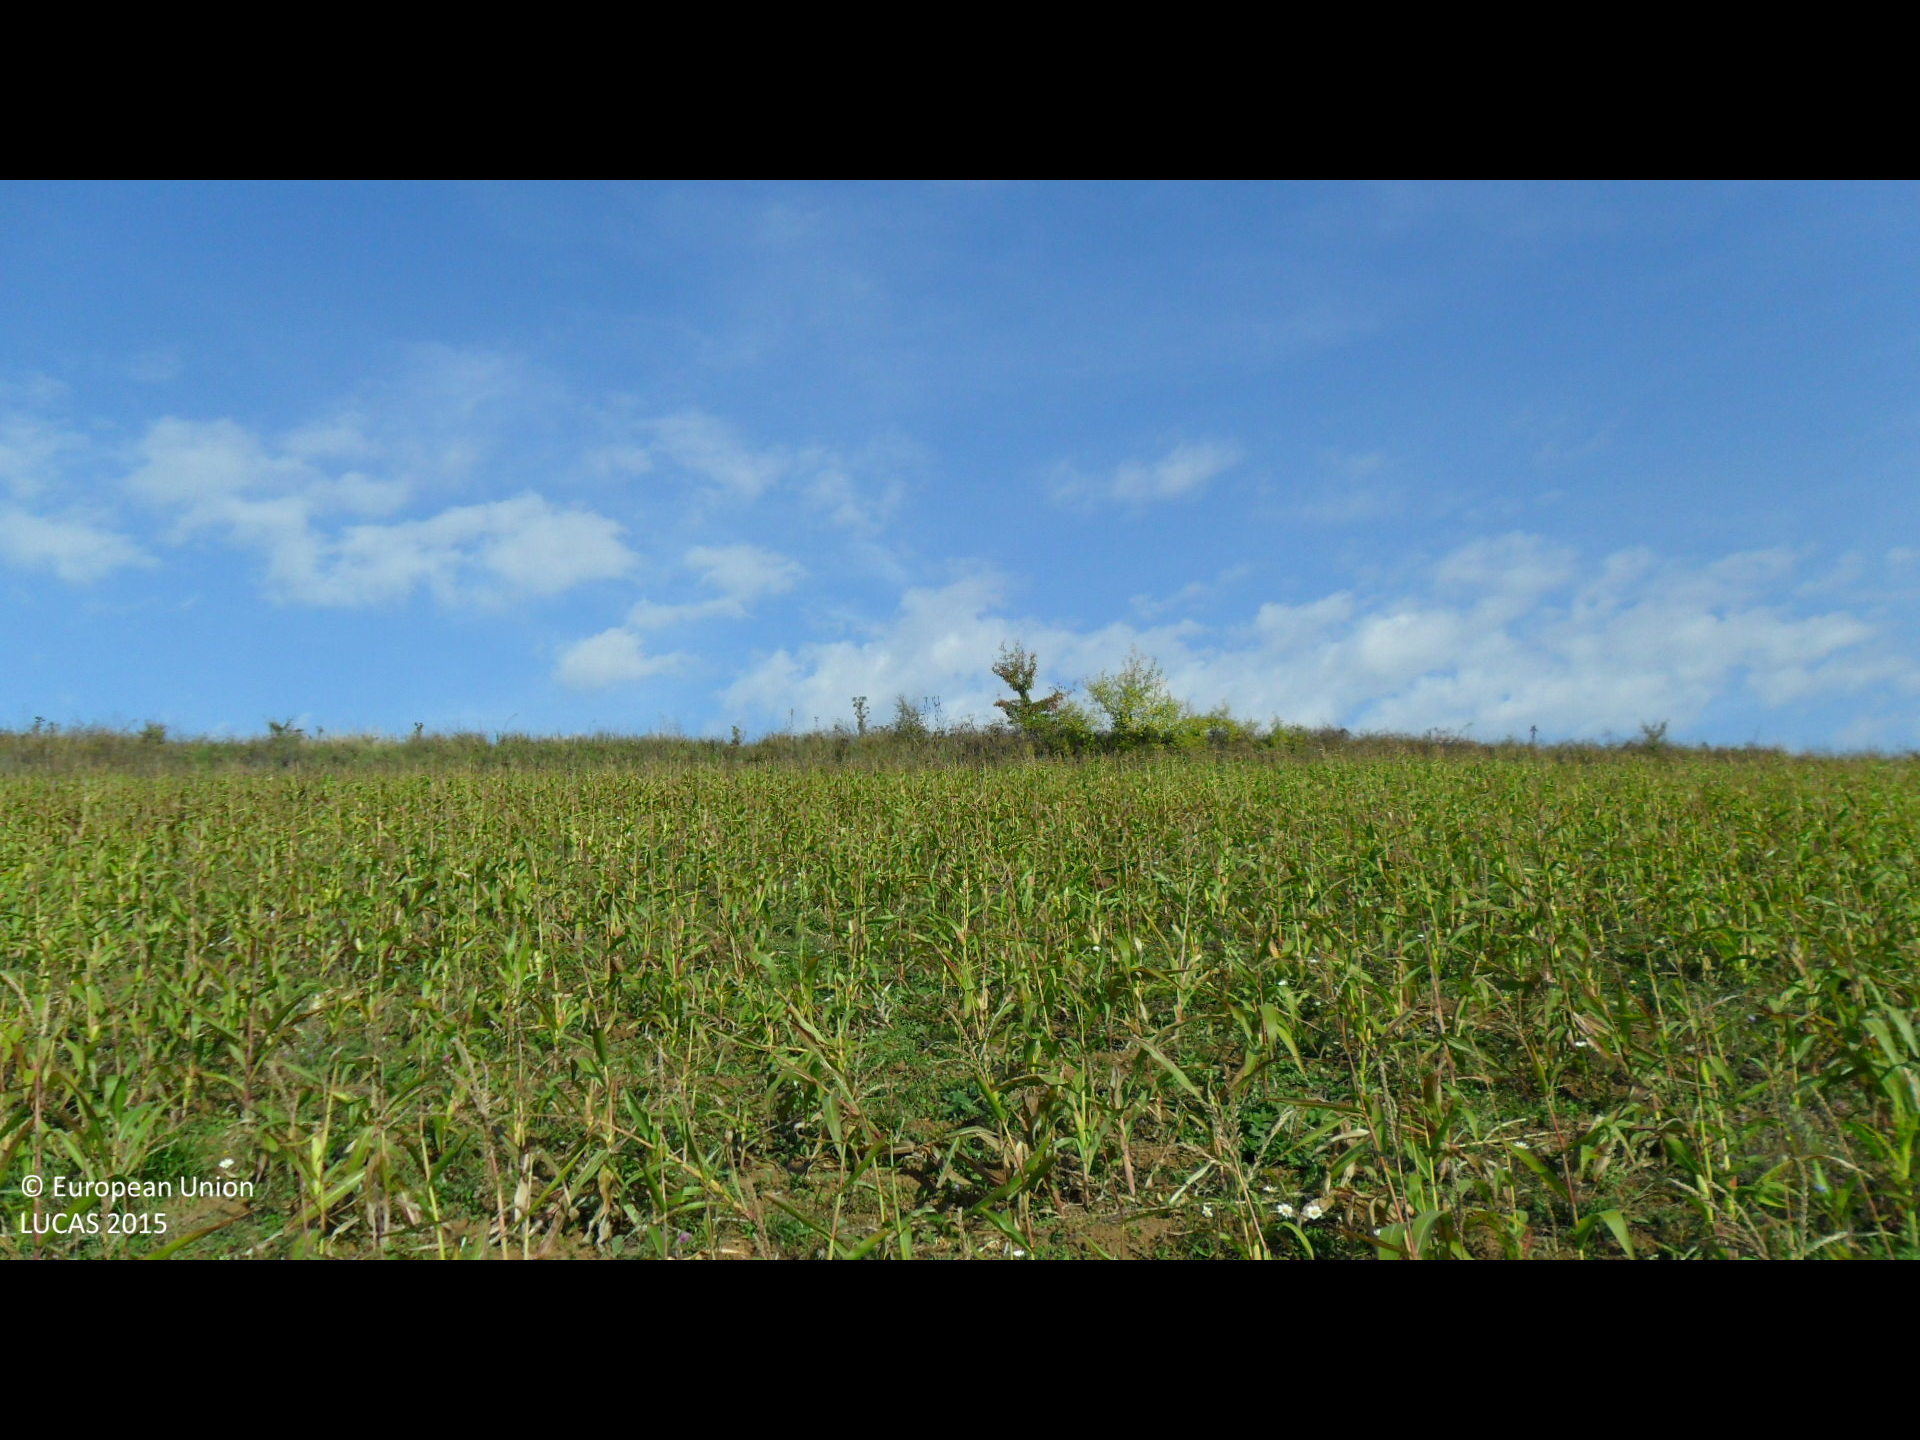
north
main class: Cropland
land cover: Maize
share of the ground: > 75 %
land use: Agriculture (excluding fallow land and kitchen gardens)
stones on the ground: < 10 %
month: October
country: BG
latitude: 43.0940
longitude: 26.1485
